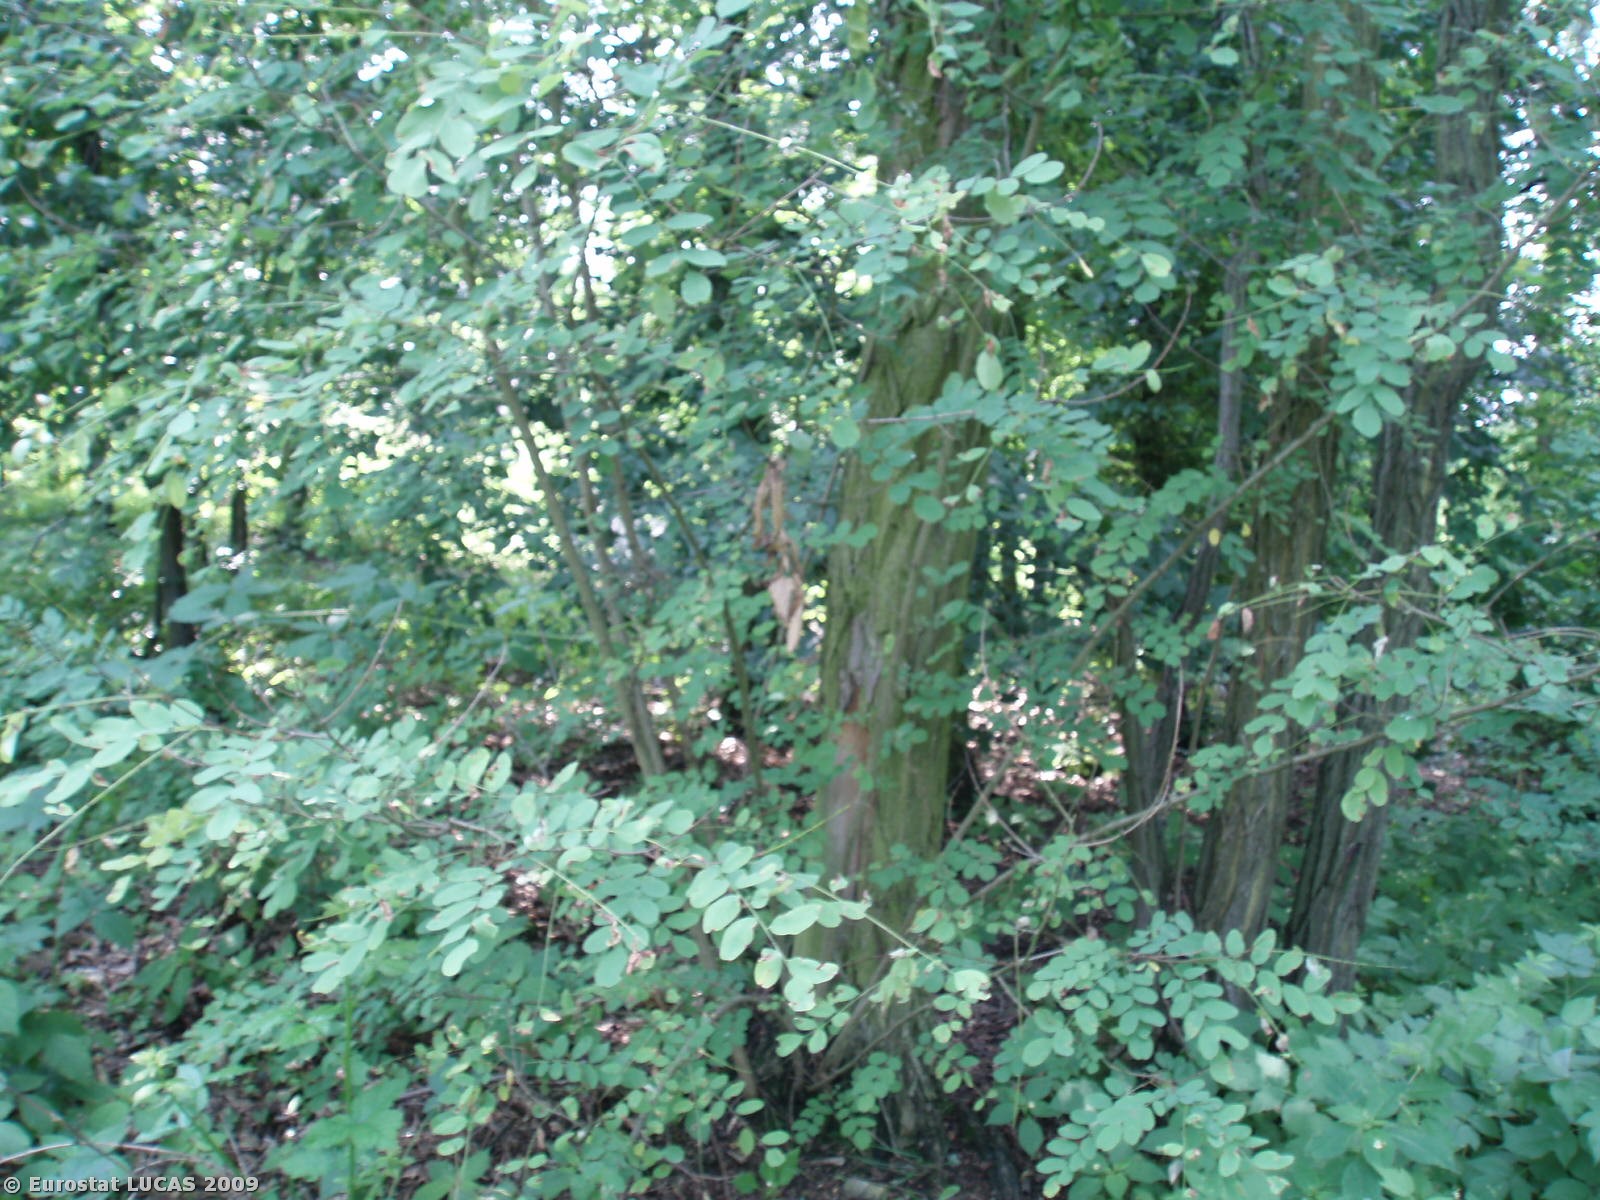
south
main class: Woodland
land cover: Broadleaved woodland
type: plantations and self-sown exotic forest
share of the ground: > 75 %
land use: Forestry
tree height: > 5 m
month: July
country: CZ
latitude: 49.9376
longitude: 14.3904
